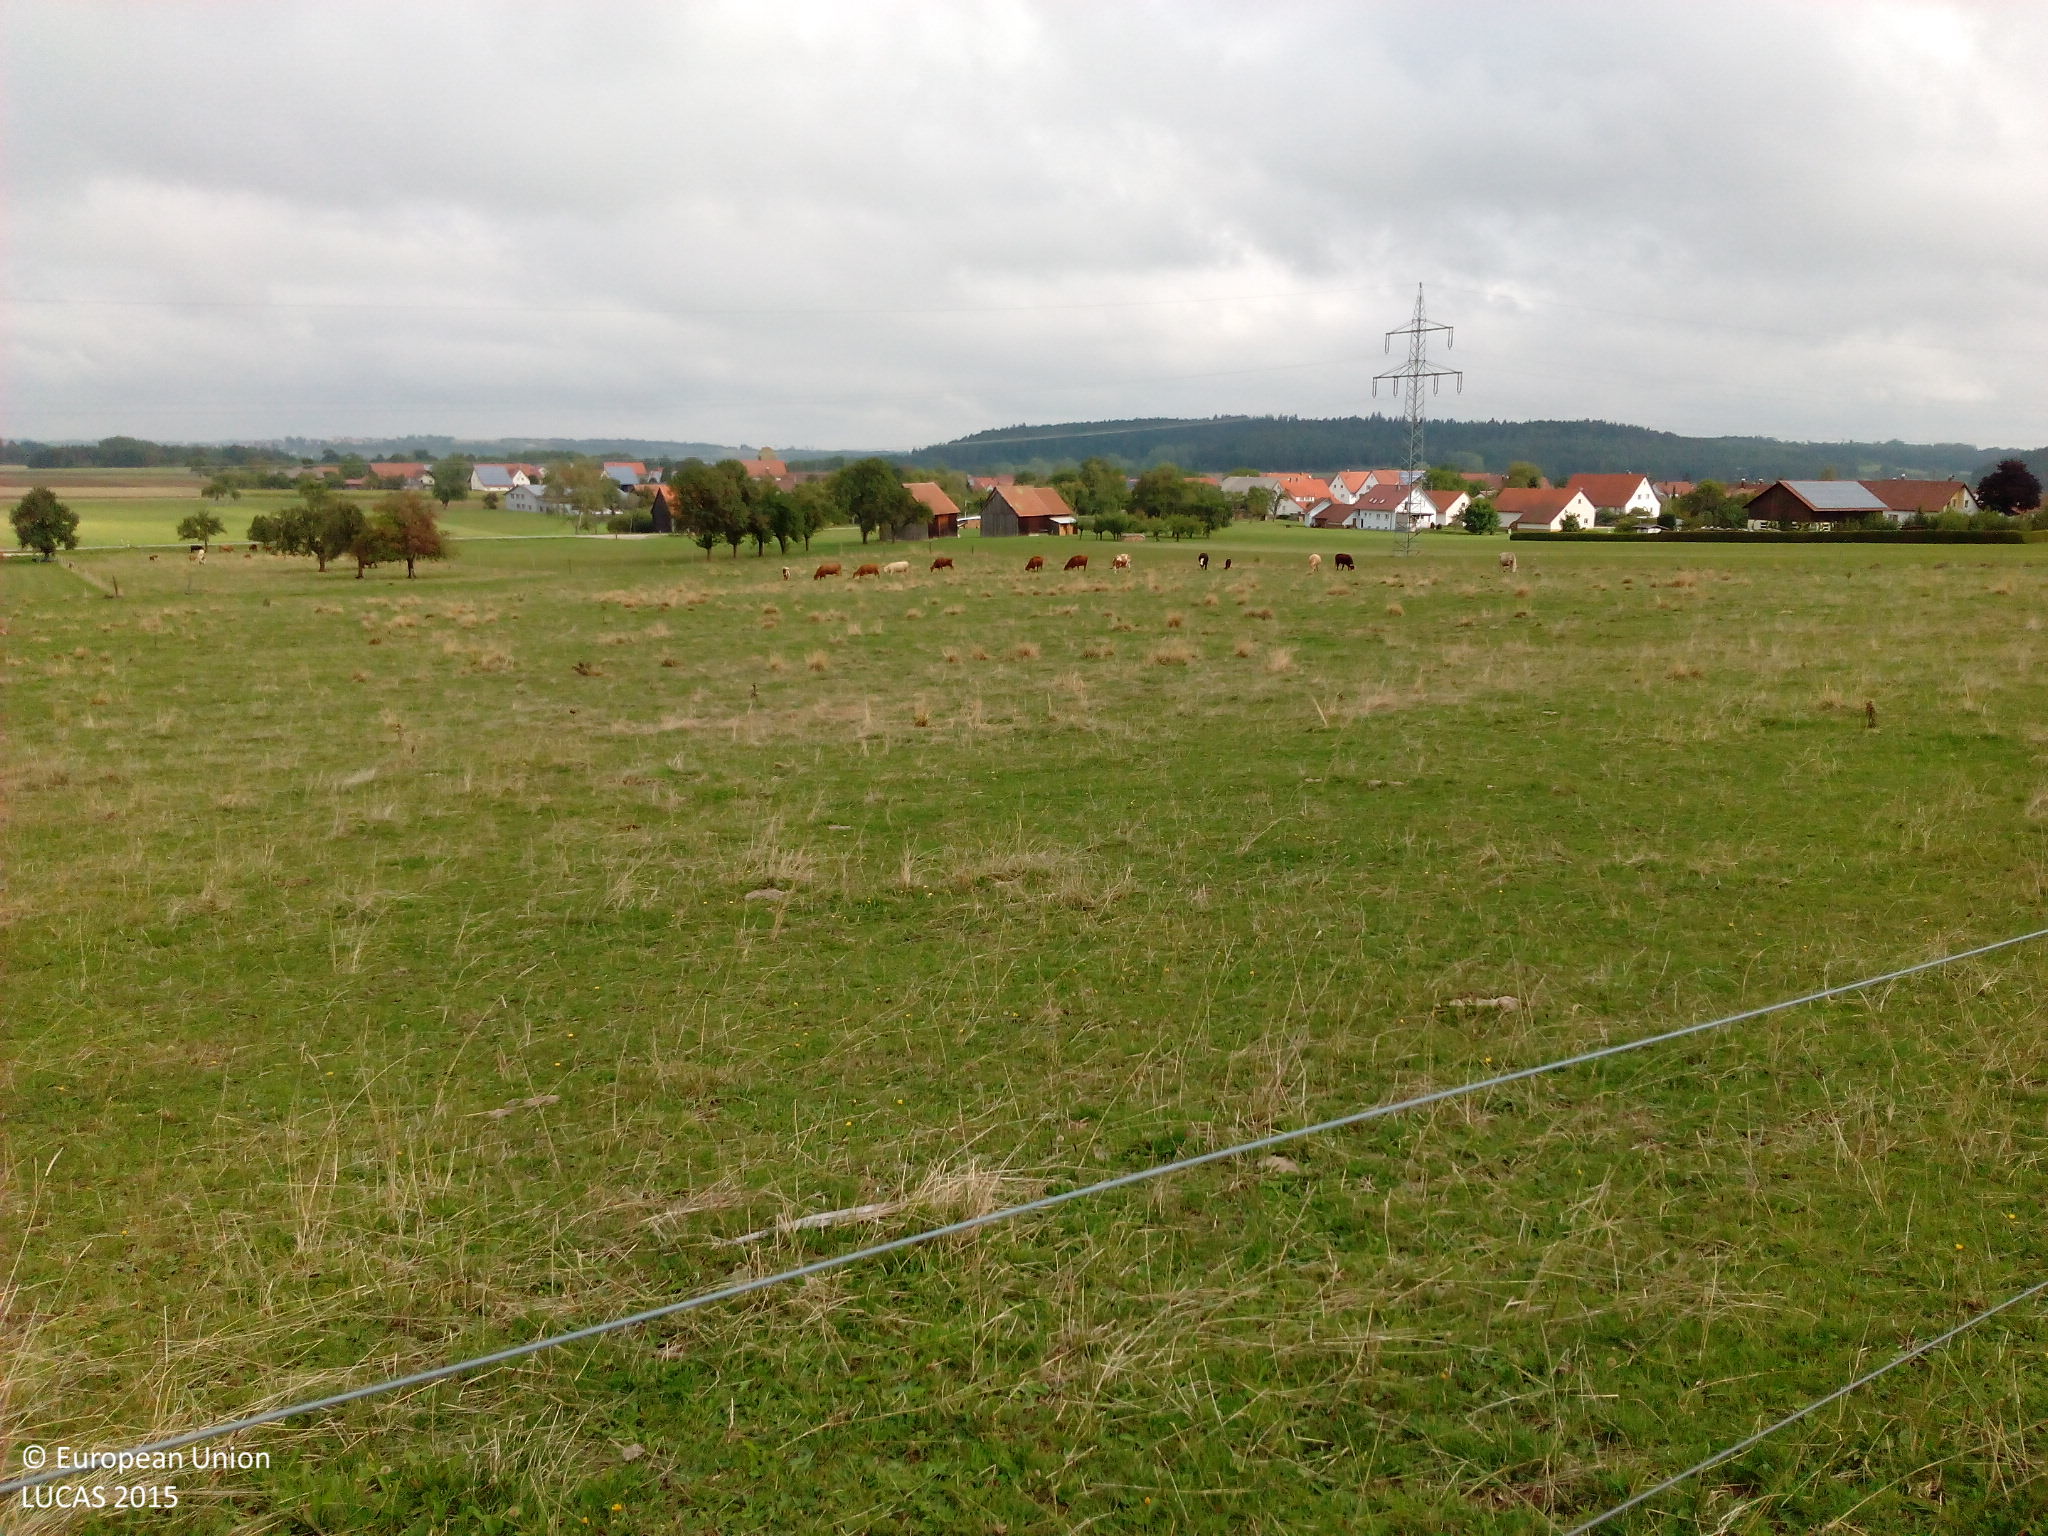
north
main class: Grassland
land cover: Grassland without tree/shrub cover
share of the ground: > 75 %
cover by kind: herbaceous plants 95 %, unconsolidated bare surface 5 %
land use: Agriculture (excluding fallow land and kitchen gardens)
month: September
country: DE
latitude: 48.2341
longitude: 8.7217
